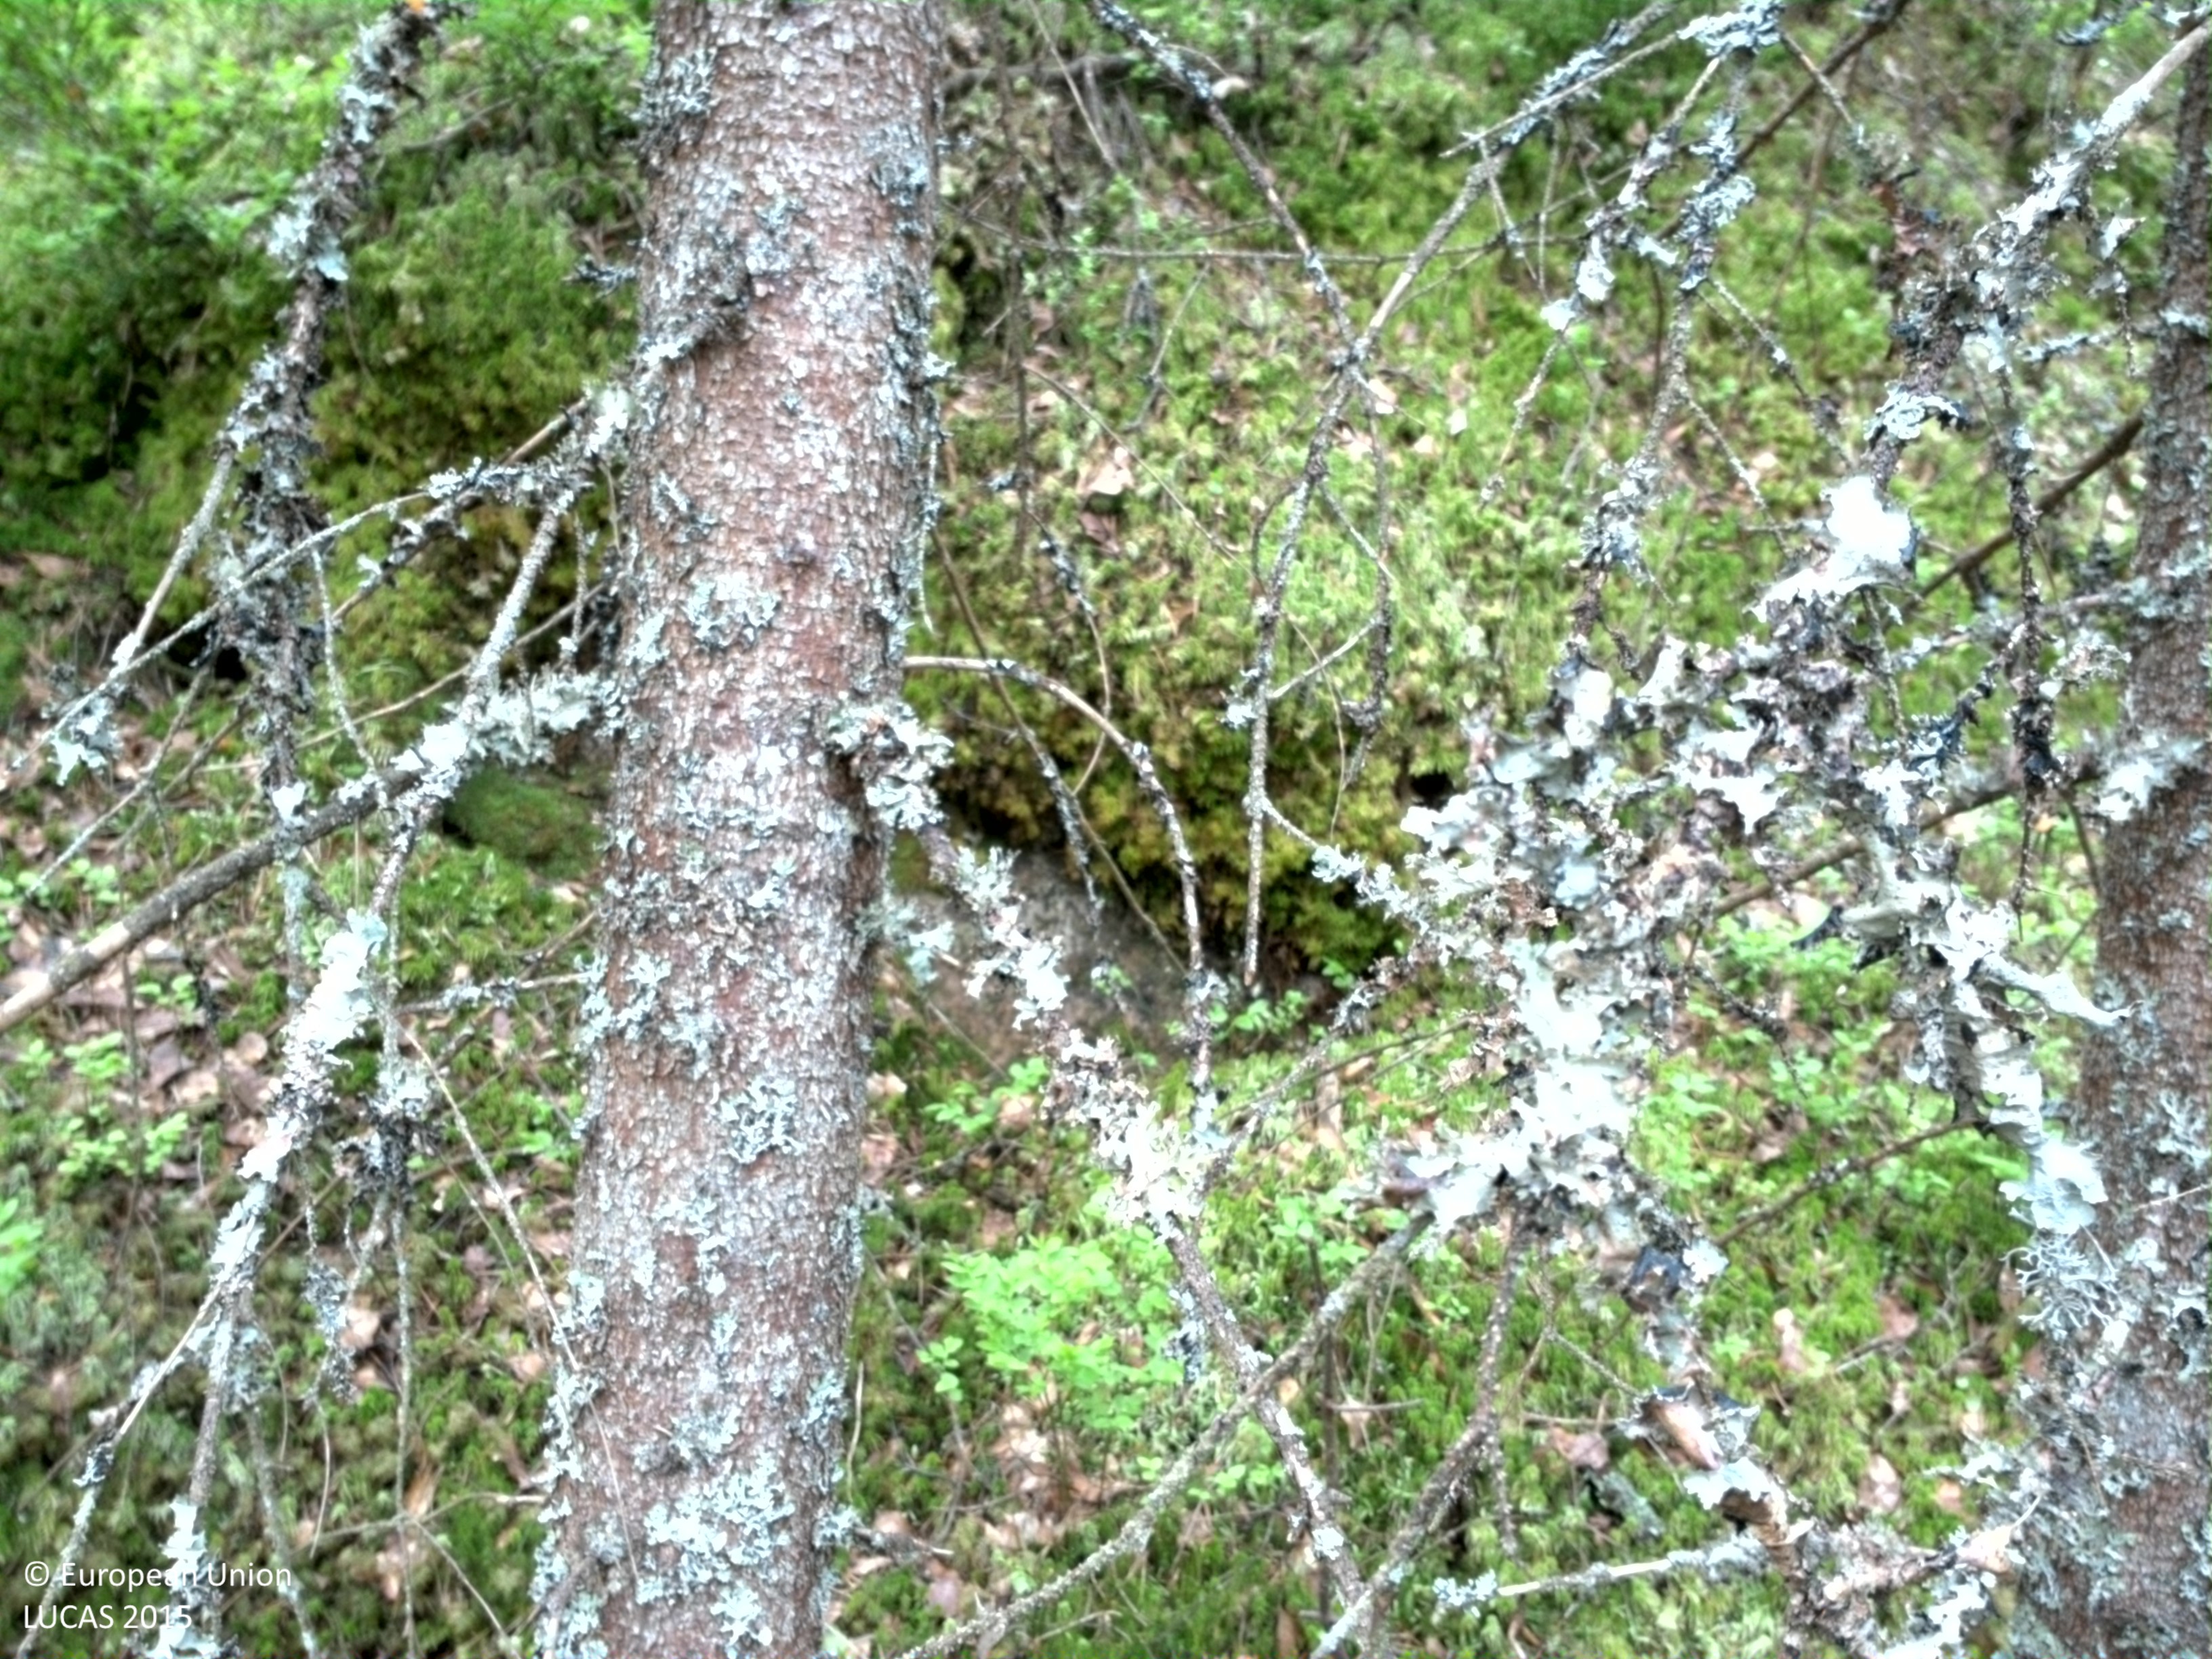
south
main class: Woodland
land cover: Spruce dominated coniferous woodland
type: boreal forest
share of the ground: 50 - 75 %
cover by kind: coniferous forest trees 60 %, shrubs 25 %, broadleaved forest trees 15 %
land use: Forestry
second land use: Amenities, museums, leisure
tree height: > 5 m
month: June
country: SE
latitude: 57.4623
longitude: 13.8463
